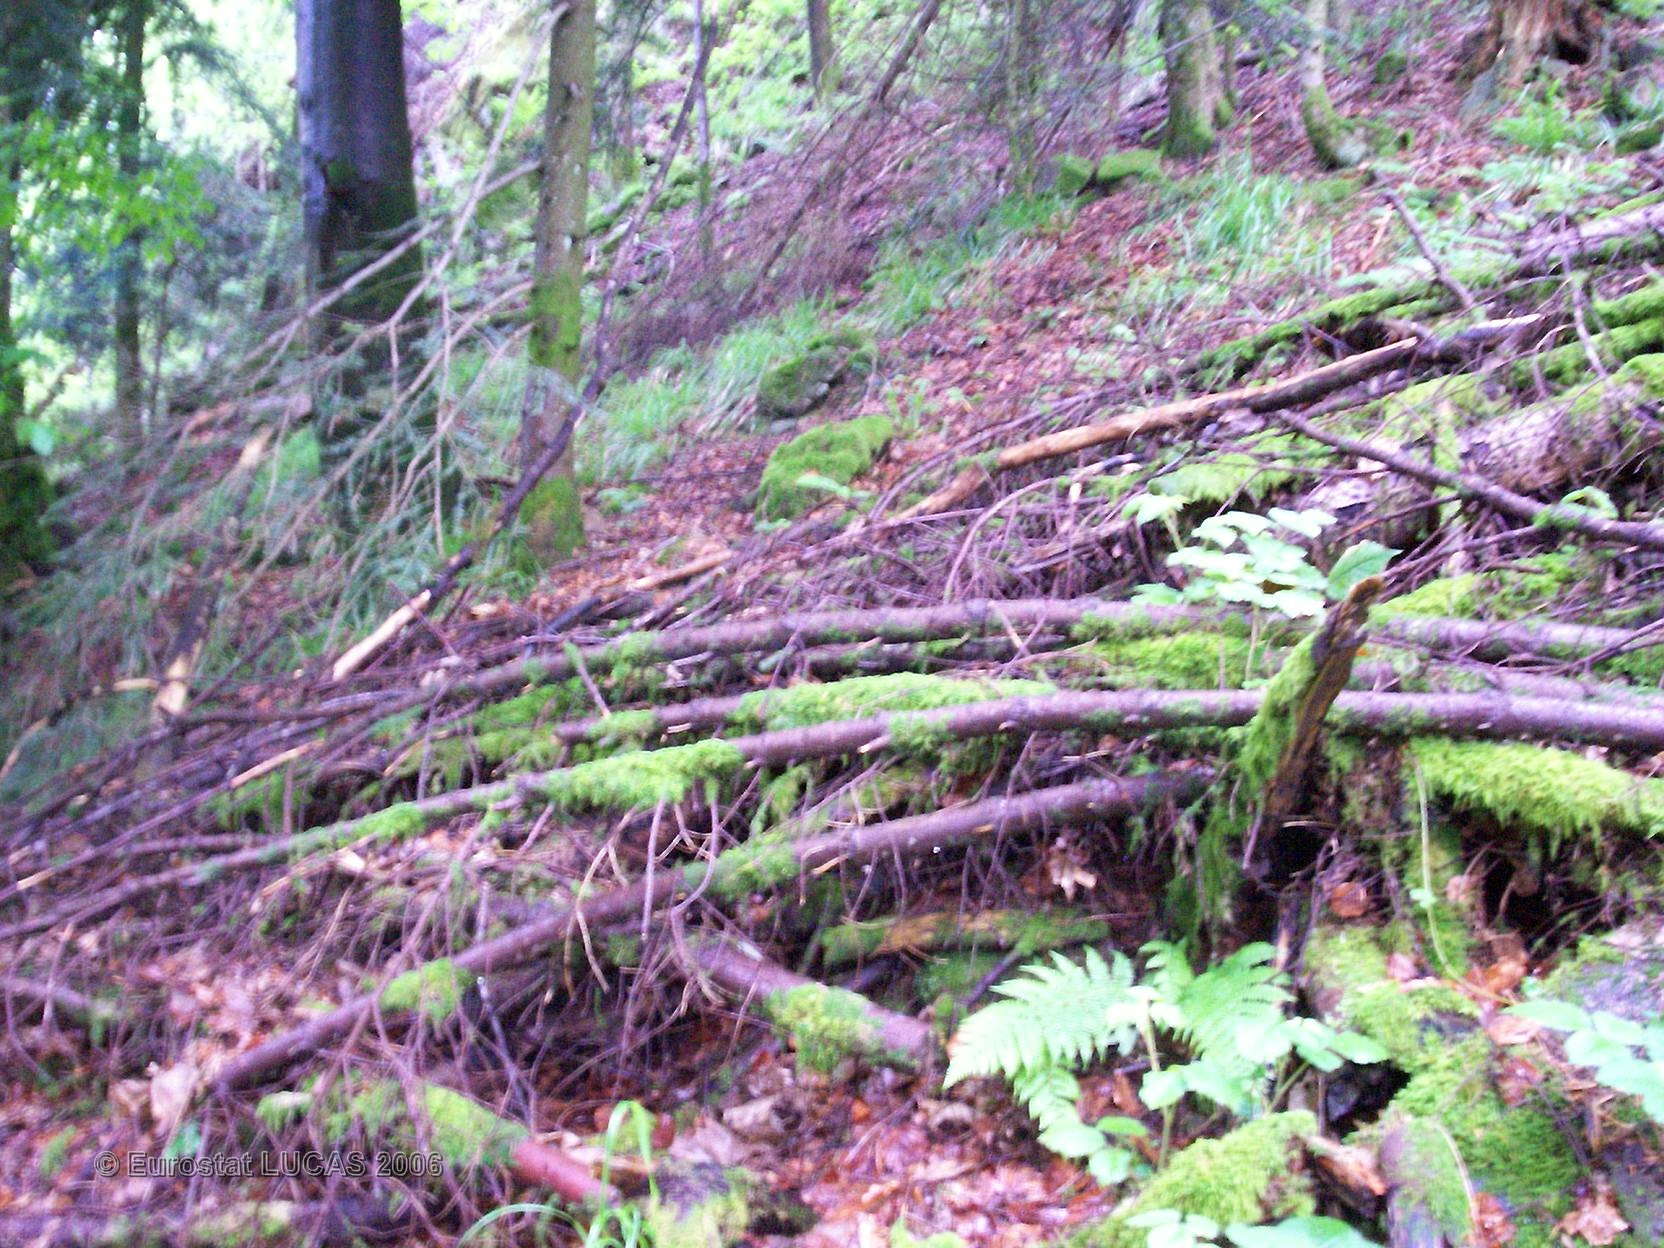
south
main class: Woodland
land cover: Mixed forest
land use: Forestry
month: June
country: FR
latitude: 47.8352
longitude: 6.8082
